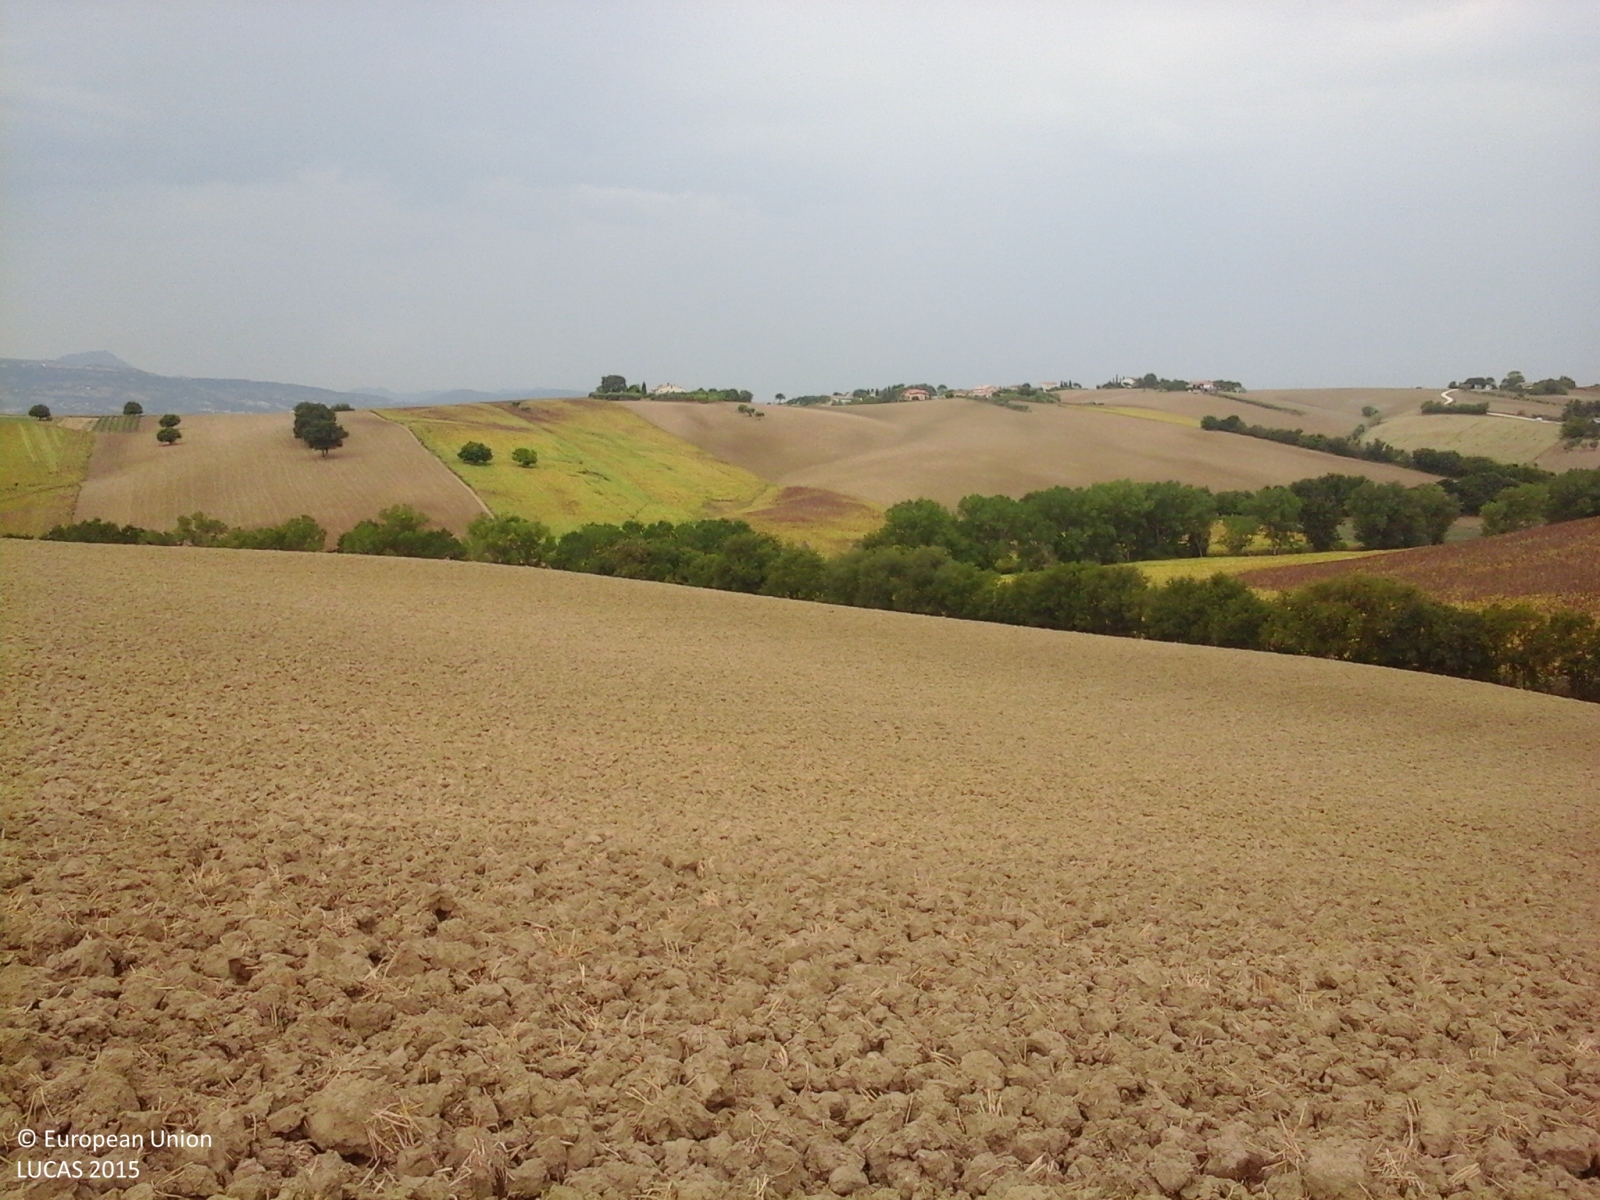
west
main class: Cropland
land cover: Durum wheat
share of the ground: > 75 %
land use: Agriculture (excluding fallow land and kitchen gardens)
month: August
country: IT
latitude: 43.4121
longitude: 13.3383
